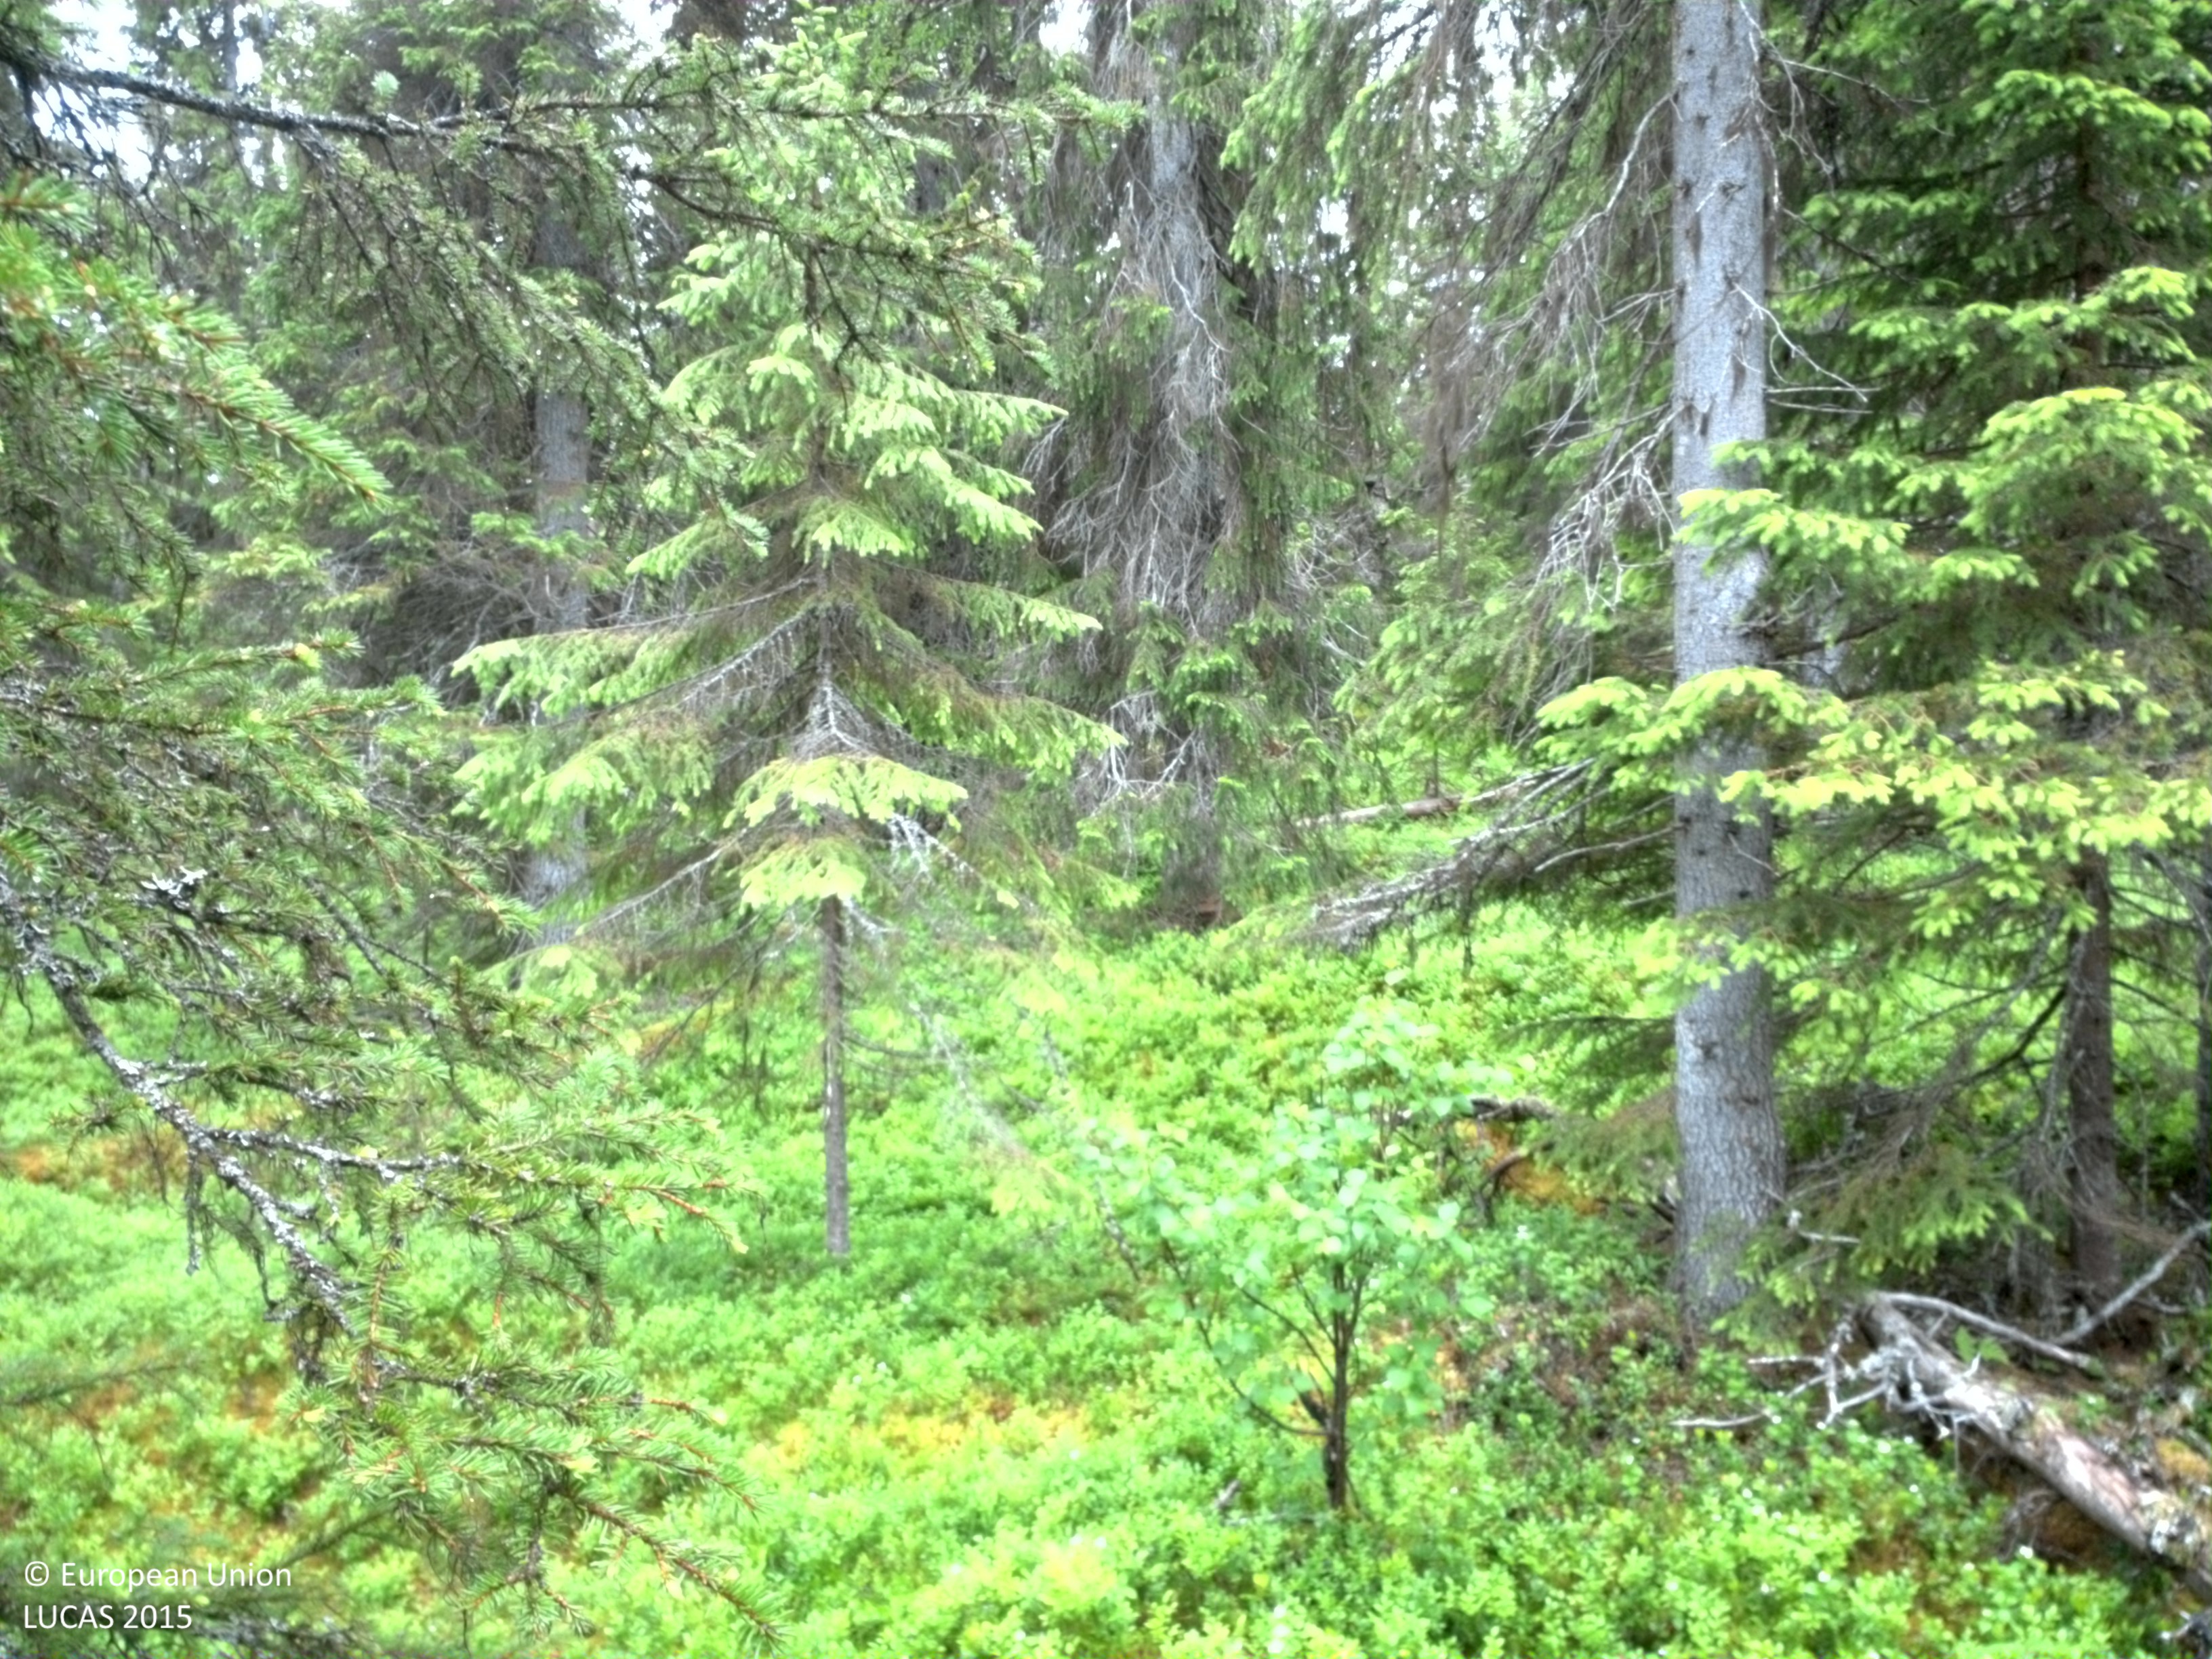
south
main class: Woodland
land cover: Spruce dominated coniferous woodland
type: boreal forest
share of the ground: 25 - 50 %
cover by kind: shrubs 45 %, coniferous forest trees 40 %, lichens and mosses 10 %, herbaceous plants 5 %
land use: Forestry
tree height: > 5 m
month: July
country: SE
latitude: 65.5128
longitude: 15.6075
